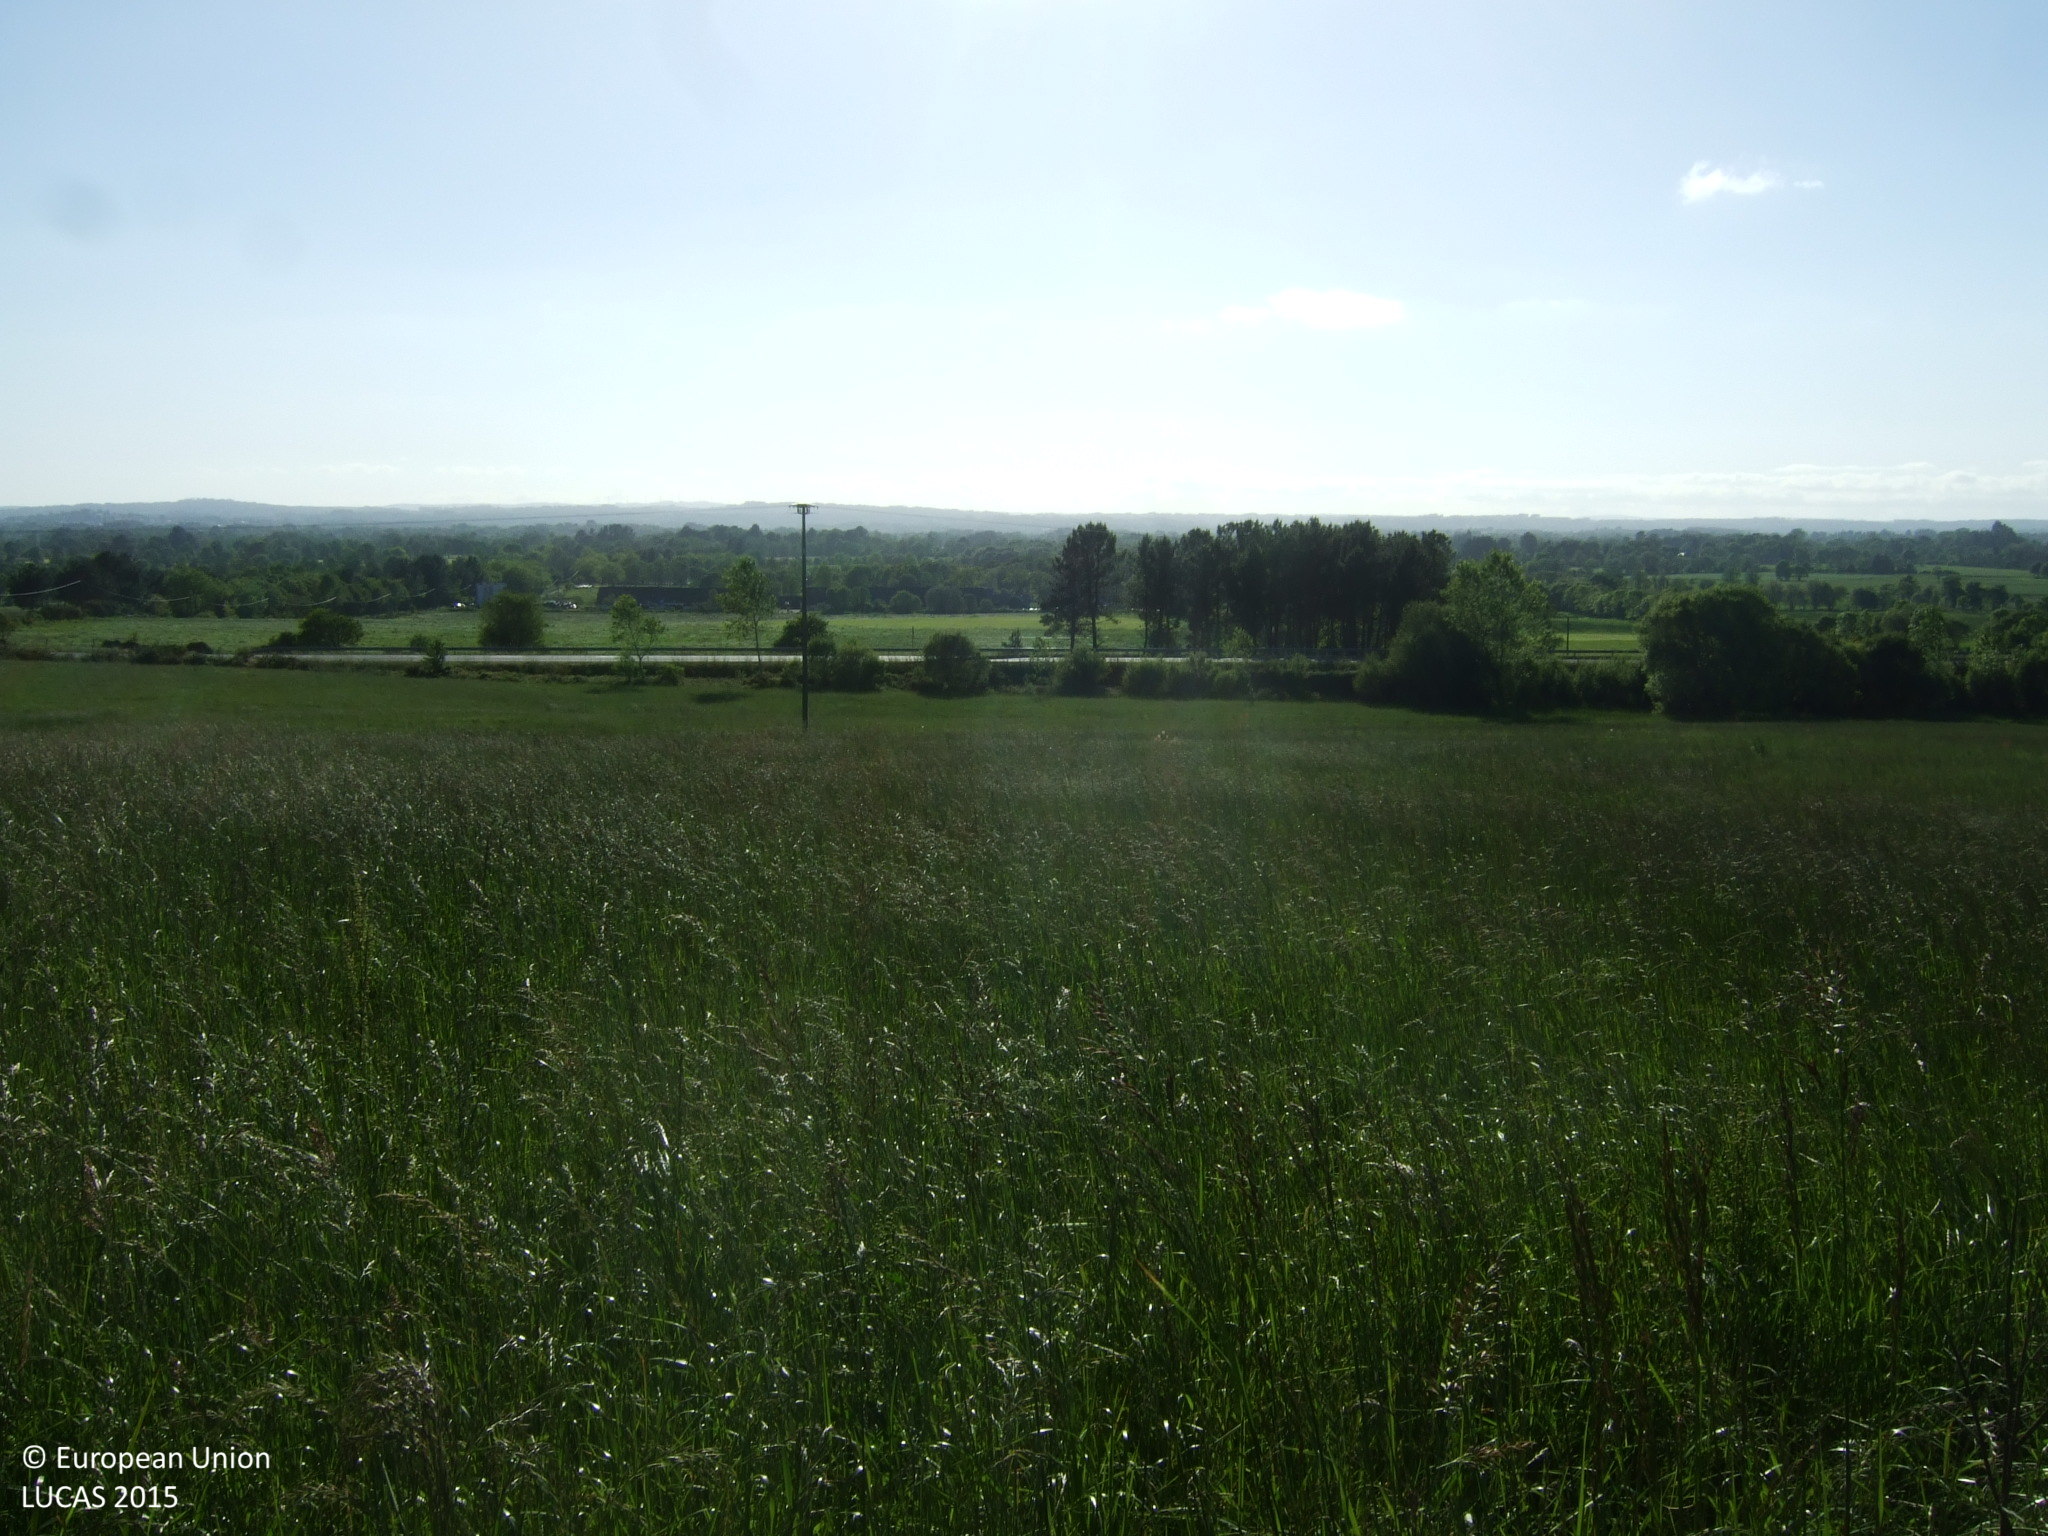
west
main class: Cropland
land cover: Temporary grasslands
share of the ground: > 75 %
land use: Agriculture (excluding fallow land and kitchen gardens)
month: May
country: ES
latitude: 43.2573
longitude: -7.4839
